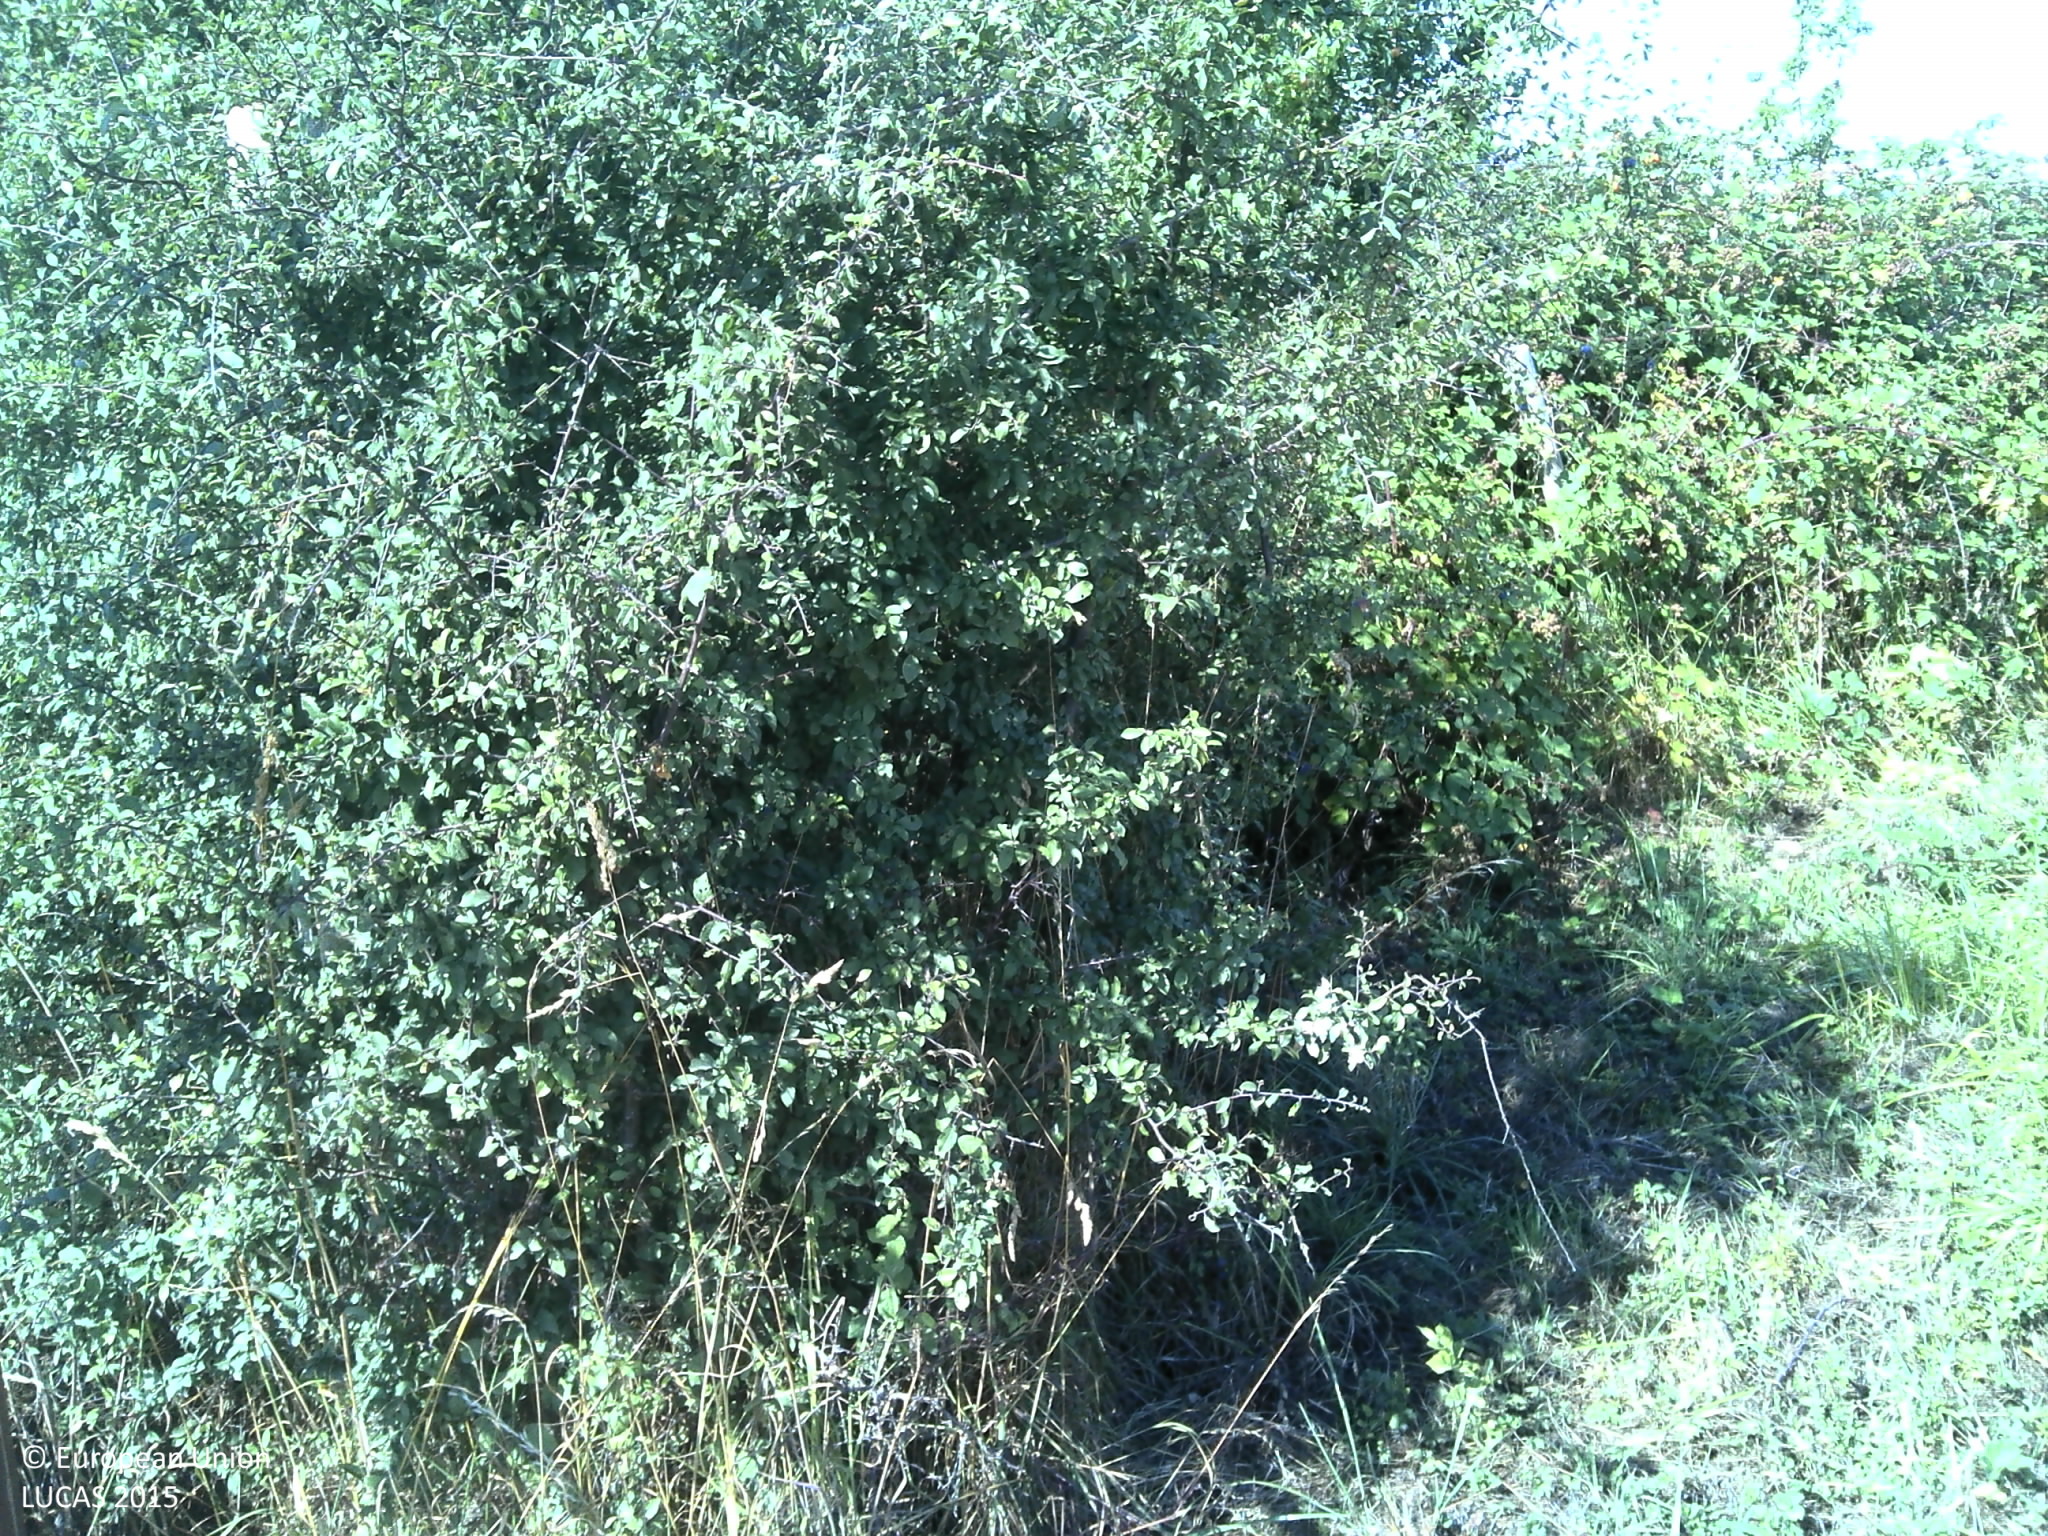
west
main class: Grassland
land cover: Grassland without tree/shrub cover
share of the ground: > 75 %
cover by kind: herbaceous plants 100 %
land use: Agriculture (excluding fallow land and kitchen gardens)
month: August
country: FR
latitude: 48.6670
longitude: 1.9064
